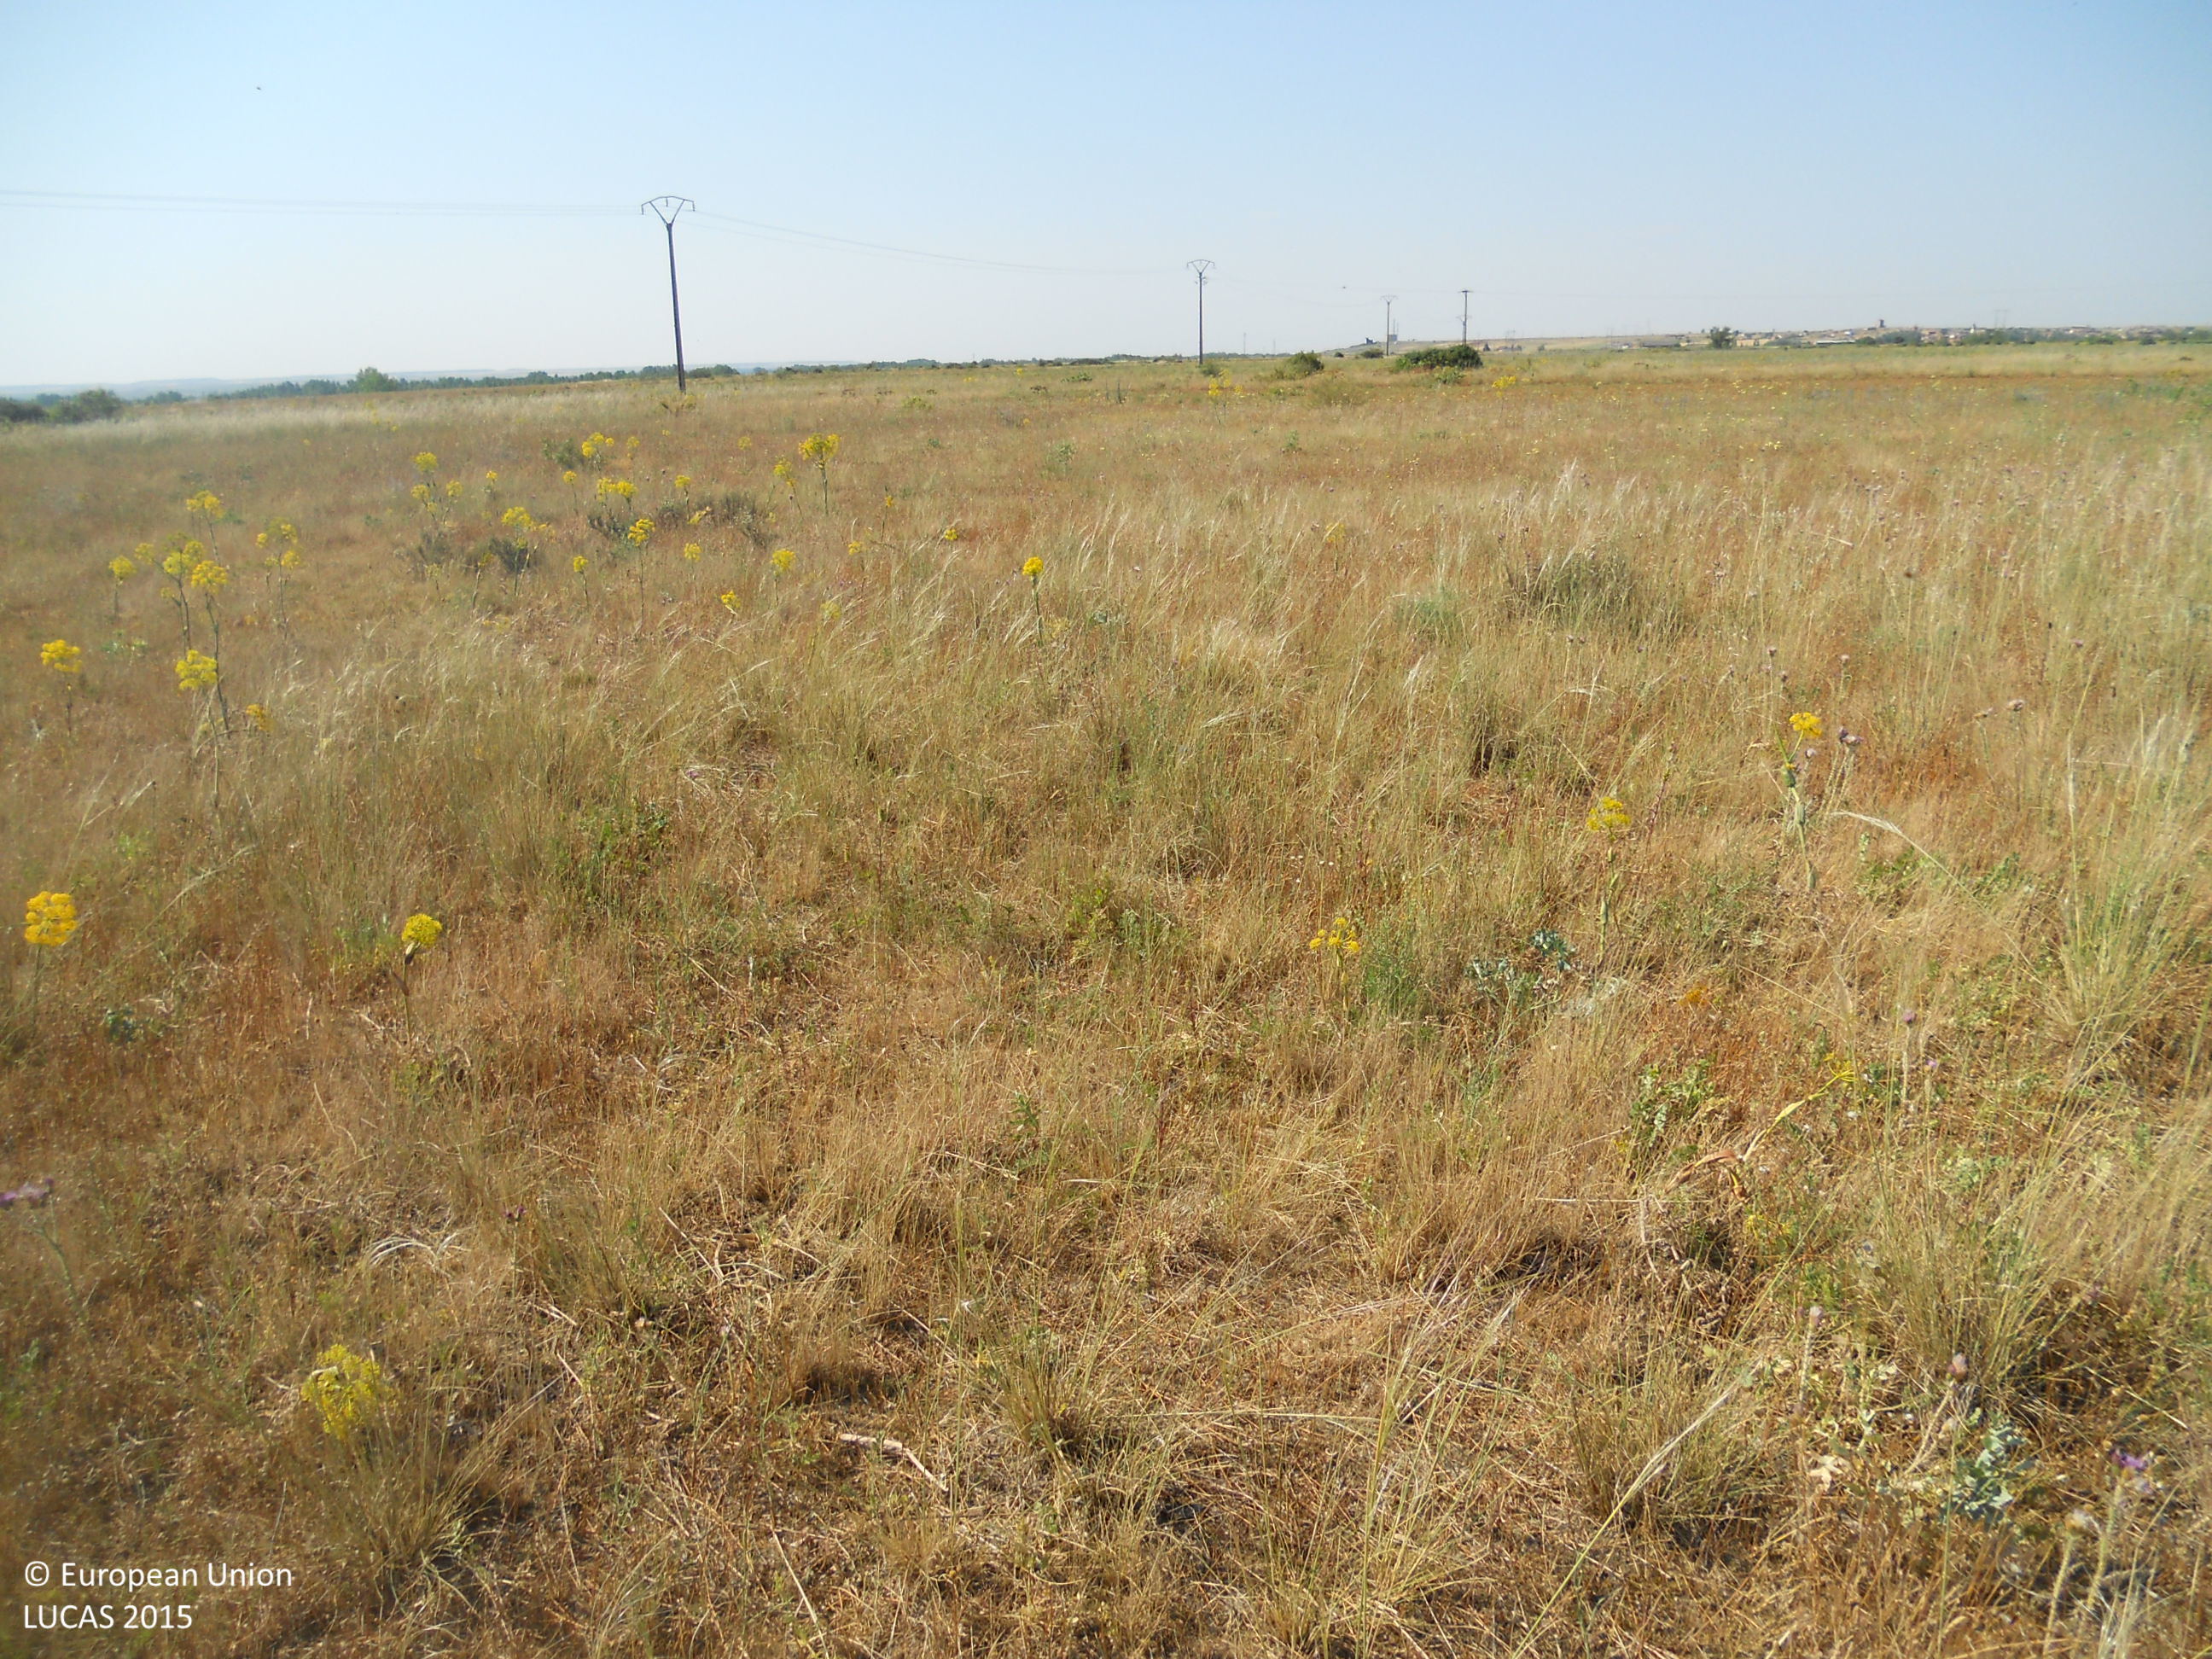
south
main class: Grassland
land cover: Grassland without tree/shrub cover
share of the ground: > 75 %
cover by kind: herbaceous plants 95 %, shrubs 5 %
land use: Semi-natural and natural areas not in use
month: June
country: ES
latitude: 42.4152
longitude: -5.5644
